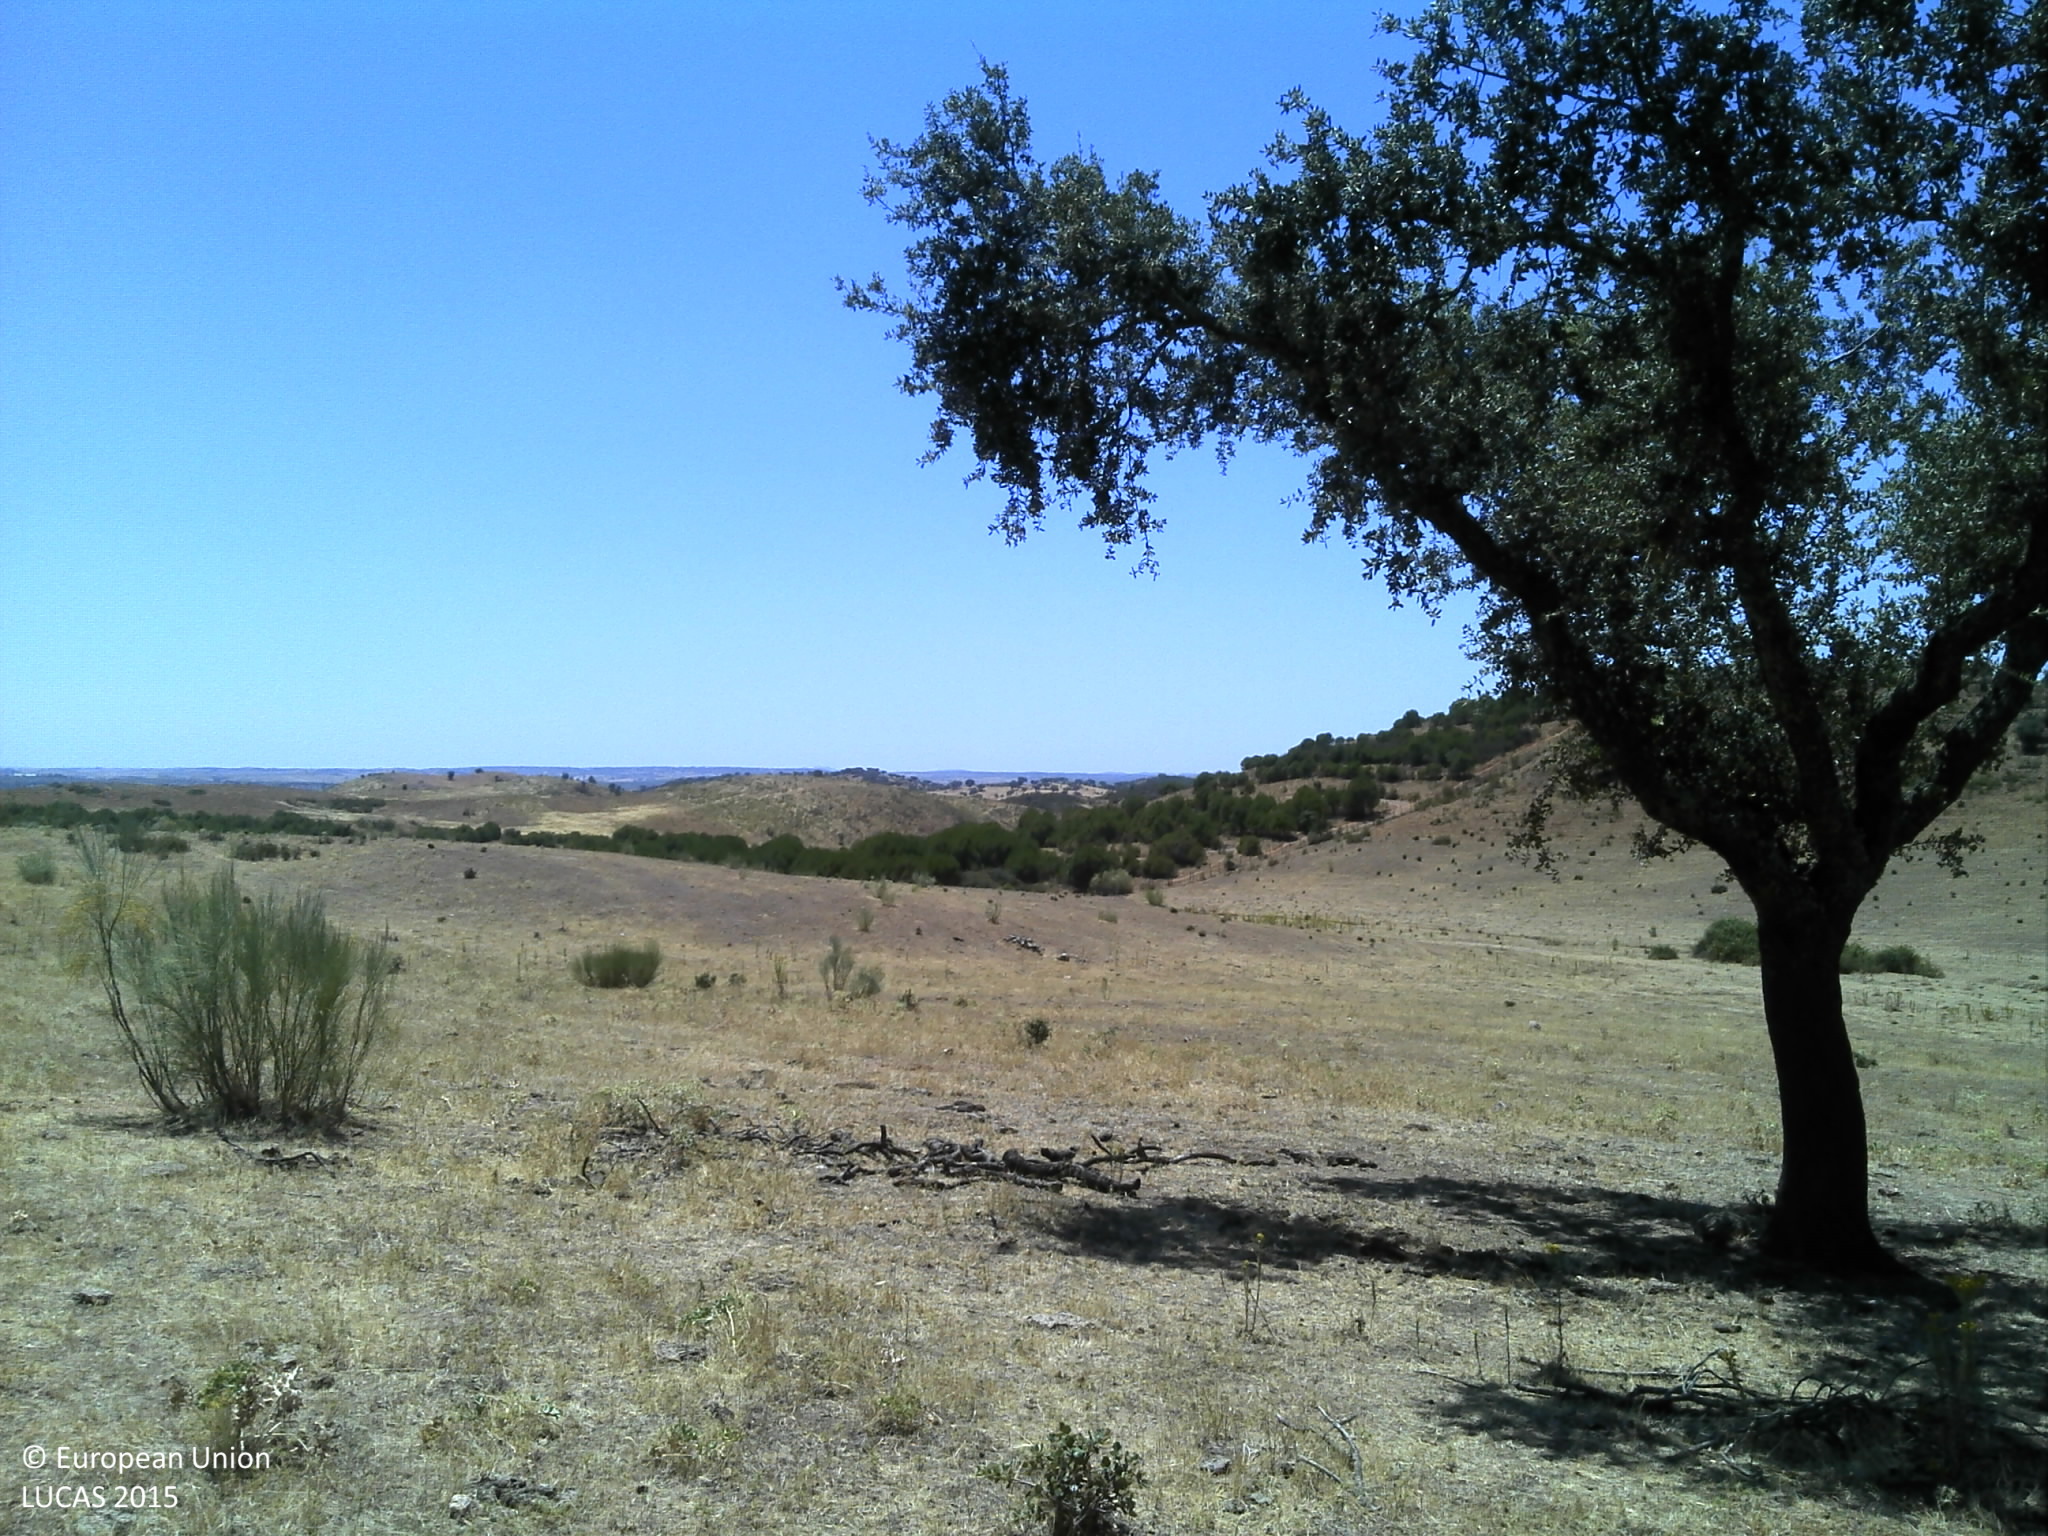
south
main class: Woodland
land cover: Broadleaved woodland
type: broadleaved evergreen forest
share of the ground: 10 - 25 %
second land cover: Grassland without tree/shrub cover
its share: 10 - 25 %
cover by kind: unconsolidated bare surface 70 %, broadleaved forest trees 15 %, herbaceous plants 15 %
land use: Forestry
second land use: Agriculture (excluding fallow land and kitchen gardens)
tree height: > 5 m
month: July
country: PT
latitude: 38.6631
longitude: -7.3941
